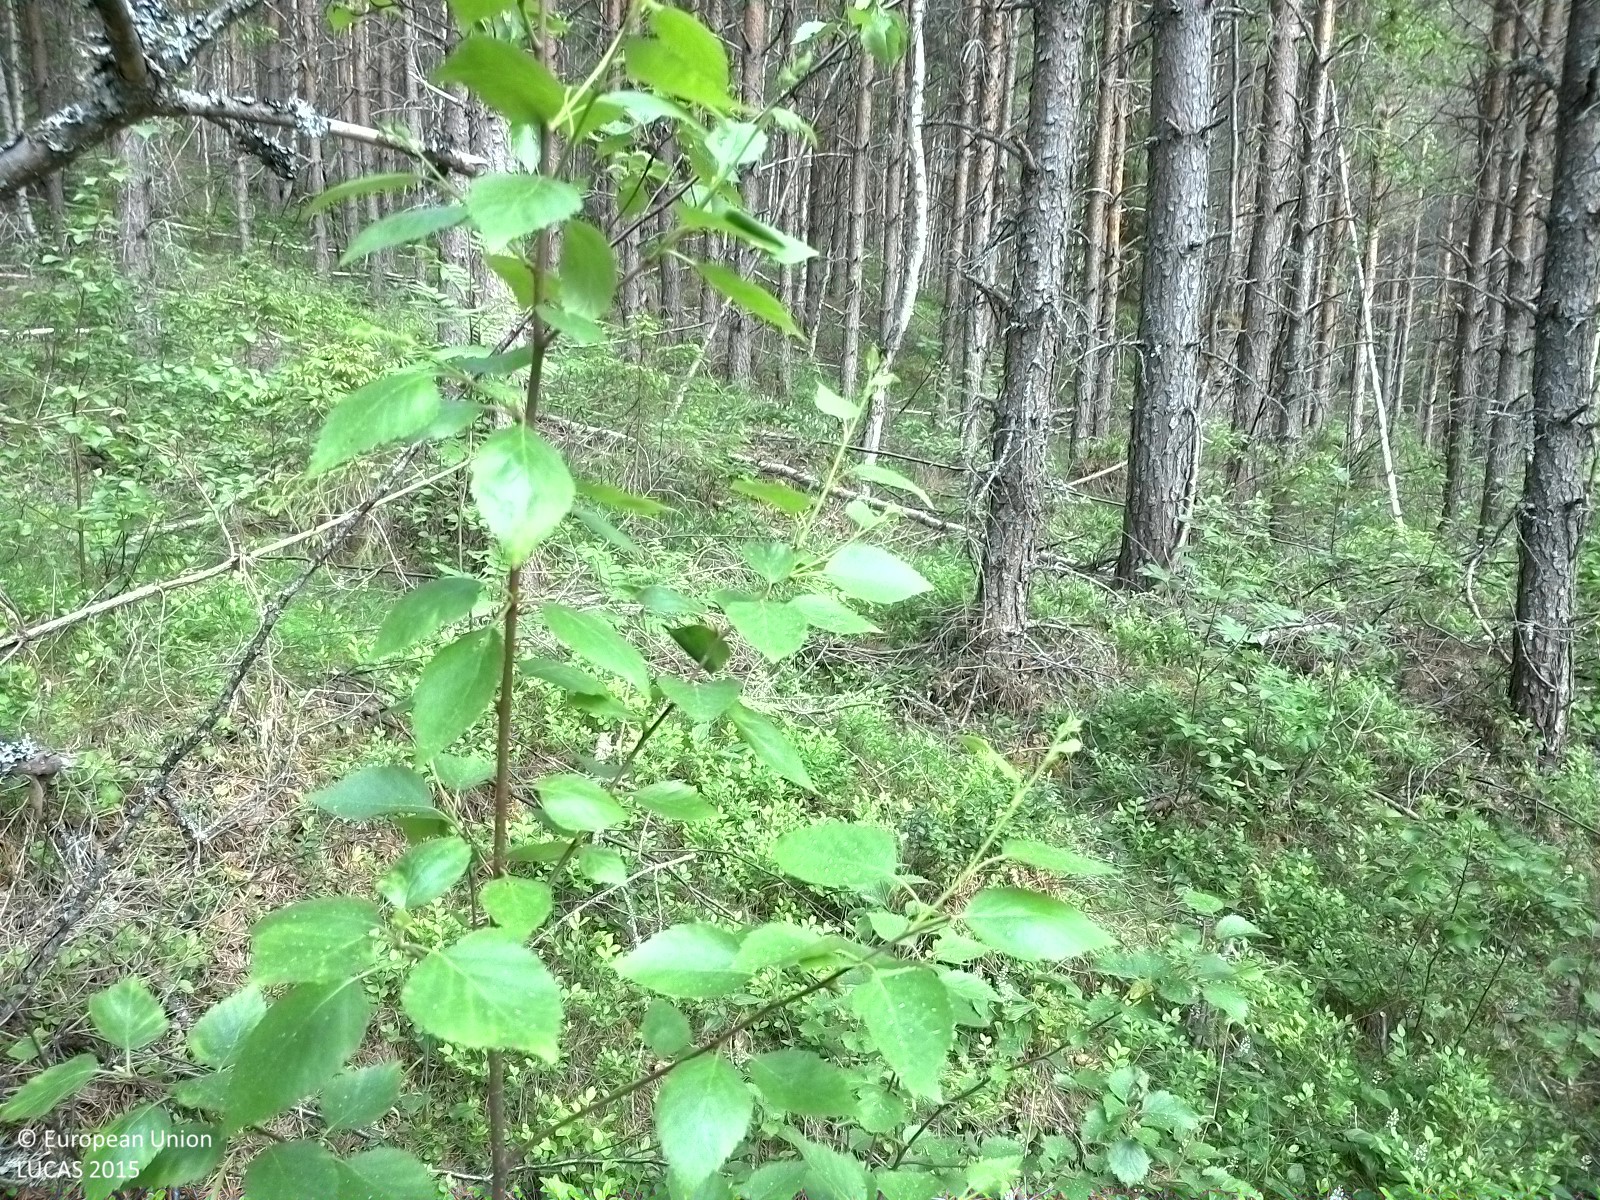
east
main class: Woodland
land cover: Pine dominated coniferous woodland
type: boreal forest
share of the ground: 25 - 50 %
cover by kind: coniferous forest trees 45 %, shrubs 40 %, herbaceous plants 10 %, broadleaved forest trees 5 %
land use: Forestry
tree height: > 5 m
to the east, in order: Pine dominated coniferous woodland; Pine dominated mixed woodland
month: June
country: SE
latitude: 62.1877
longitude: 16.3784
